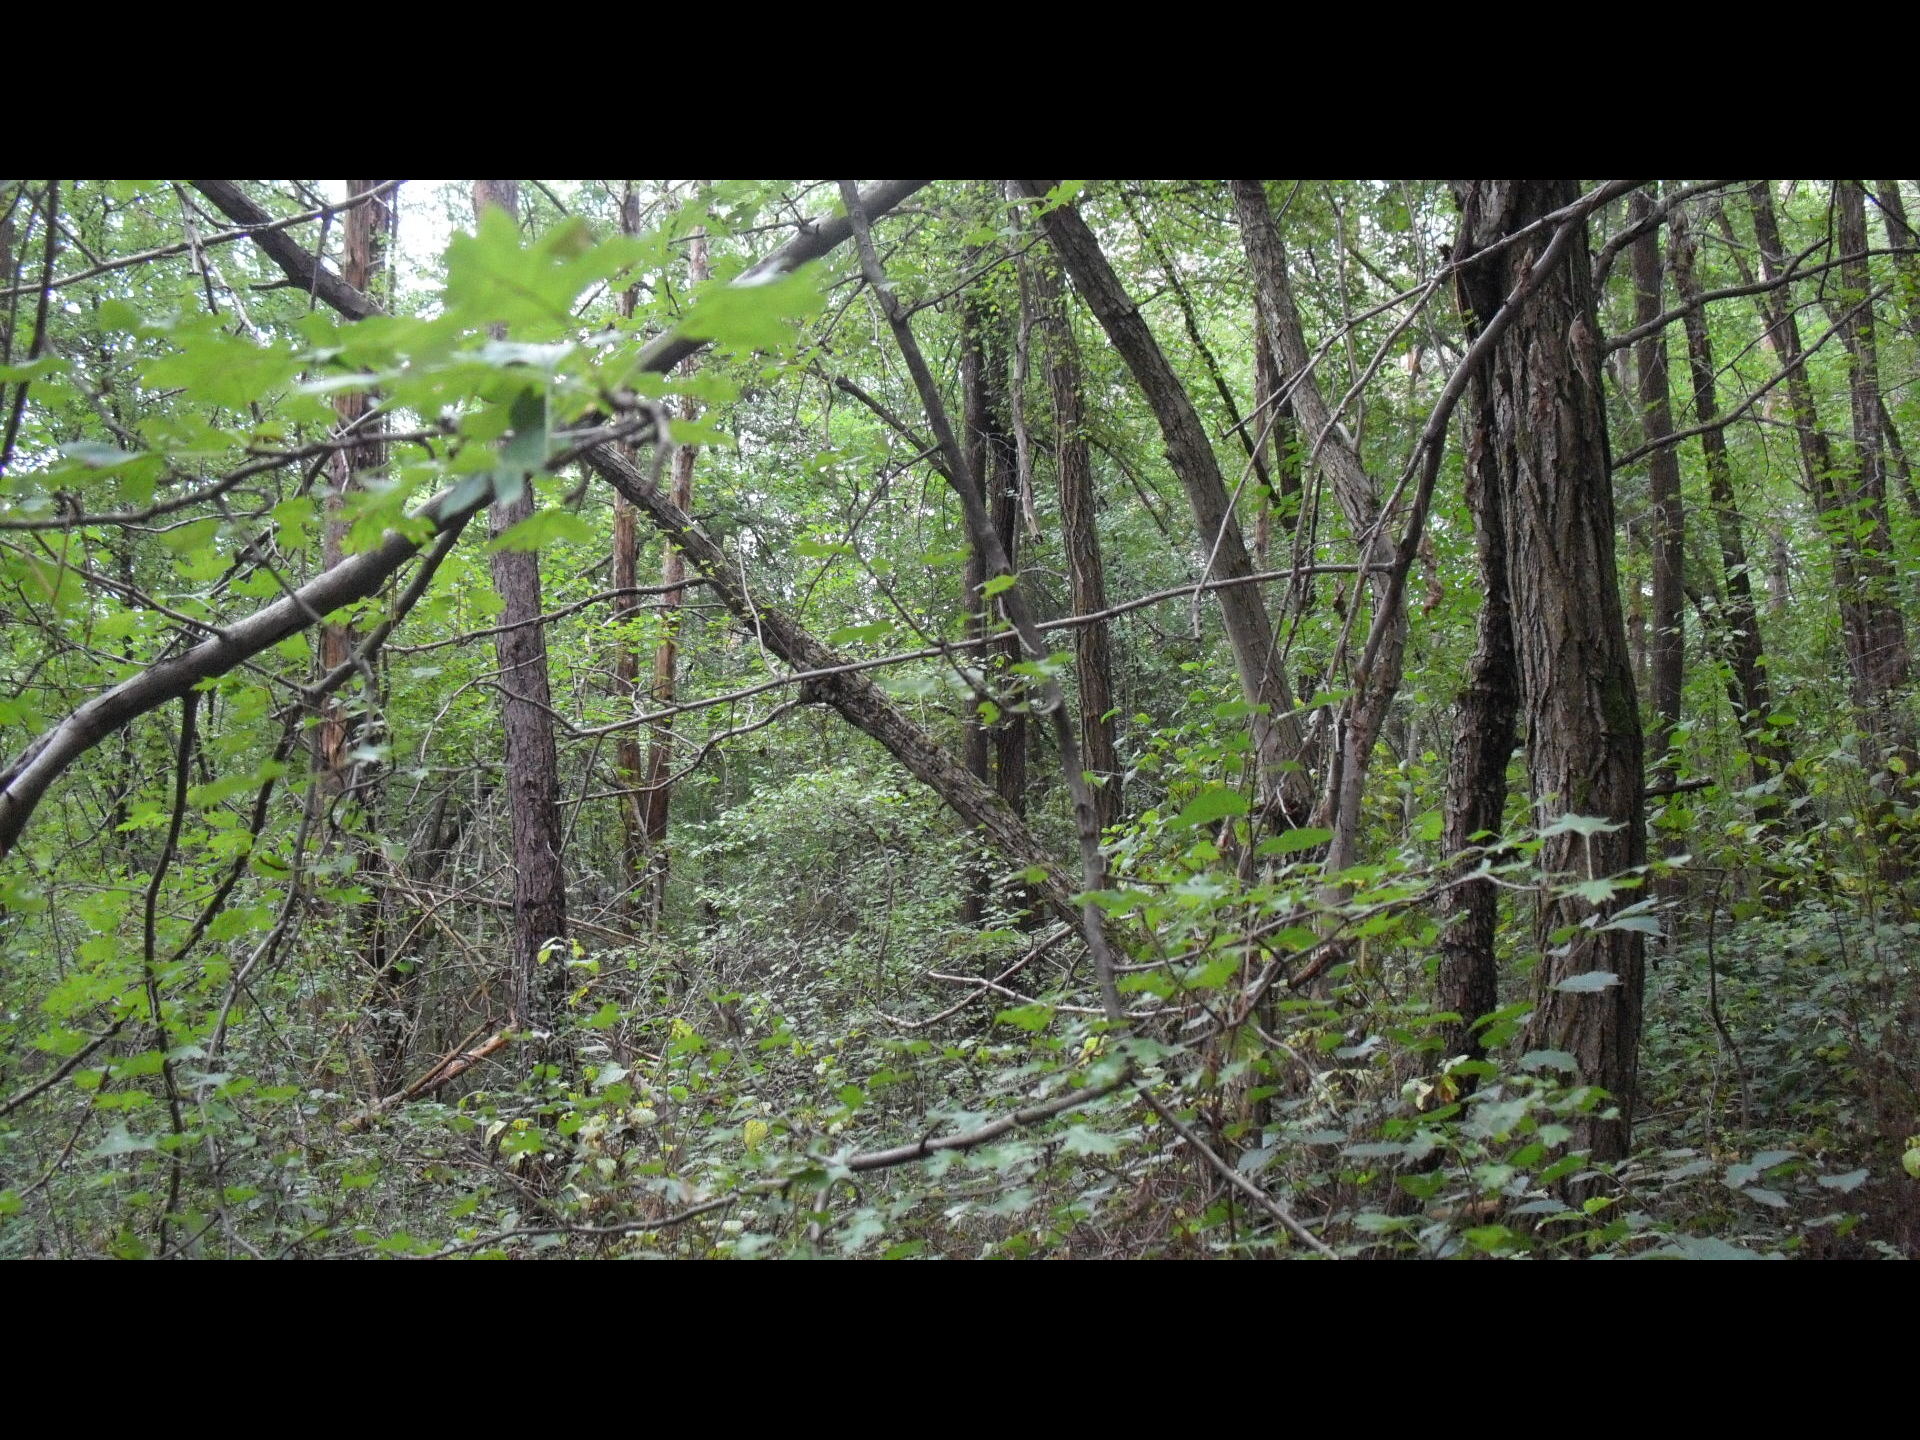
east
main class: Woodland
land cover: Pine dominated mixed woodland
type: hemiboreal forest and nemoral coniferous forest and mixed broadleaved-coniferous forest
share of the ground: > 75 %
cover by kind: coniferous forest trees 75 %, broadleaved forest trees 25 %
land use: Forestry
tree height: > 5 m
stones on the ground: 10 - 25 %
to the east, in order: Pine dominated mixed woodland; Tracks; Grassland with sparse tree/shrub cover; Broadleaved woodland; Grassland without tree/shrub cover
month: September
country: BG
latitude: 43.3337
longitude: 23.0984
